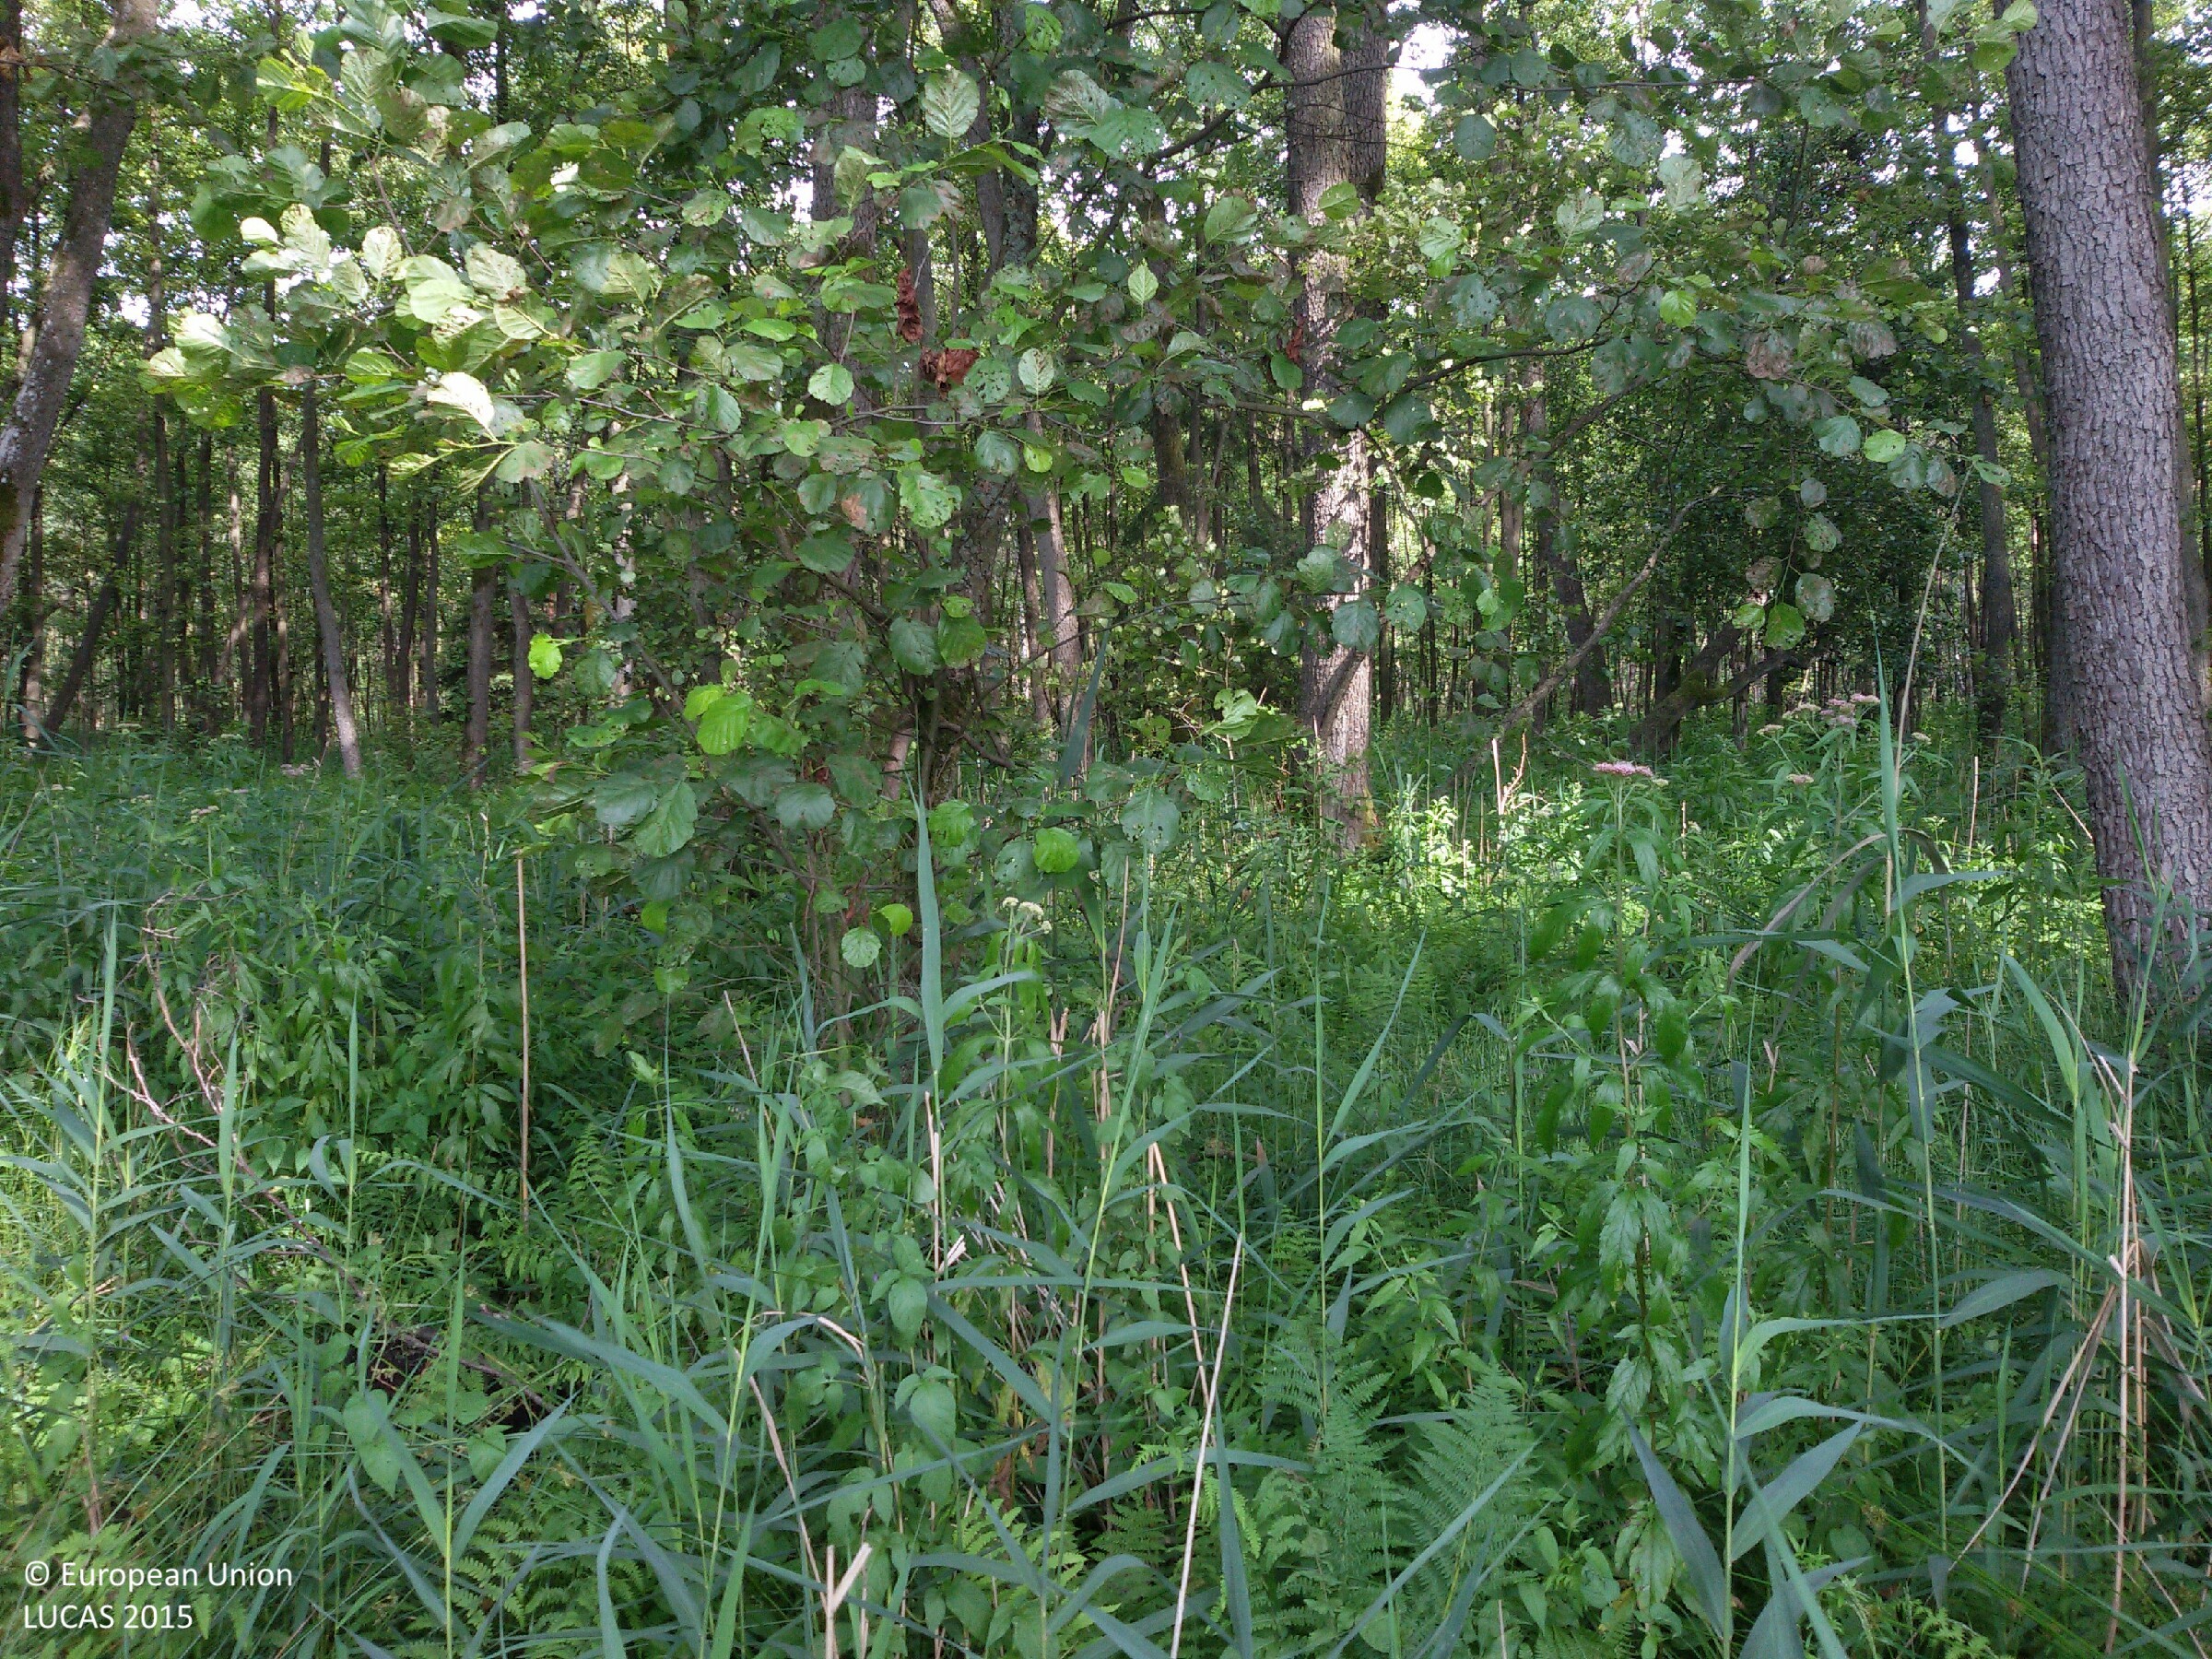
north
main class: Woodland
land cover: Broadleaved woodland
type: non-riverine alder, birch or aspen forest
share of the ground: > 75 %
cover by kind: broadleaved forest trees 90 %, herbaceous plants 10 %
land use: Forestry
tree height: > 5 m
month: July
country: PL
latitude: 53.0865
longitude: 15.7226
